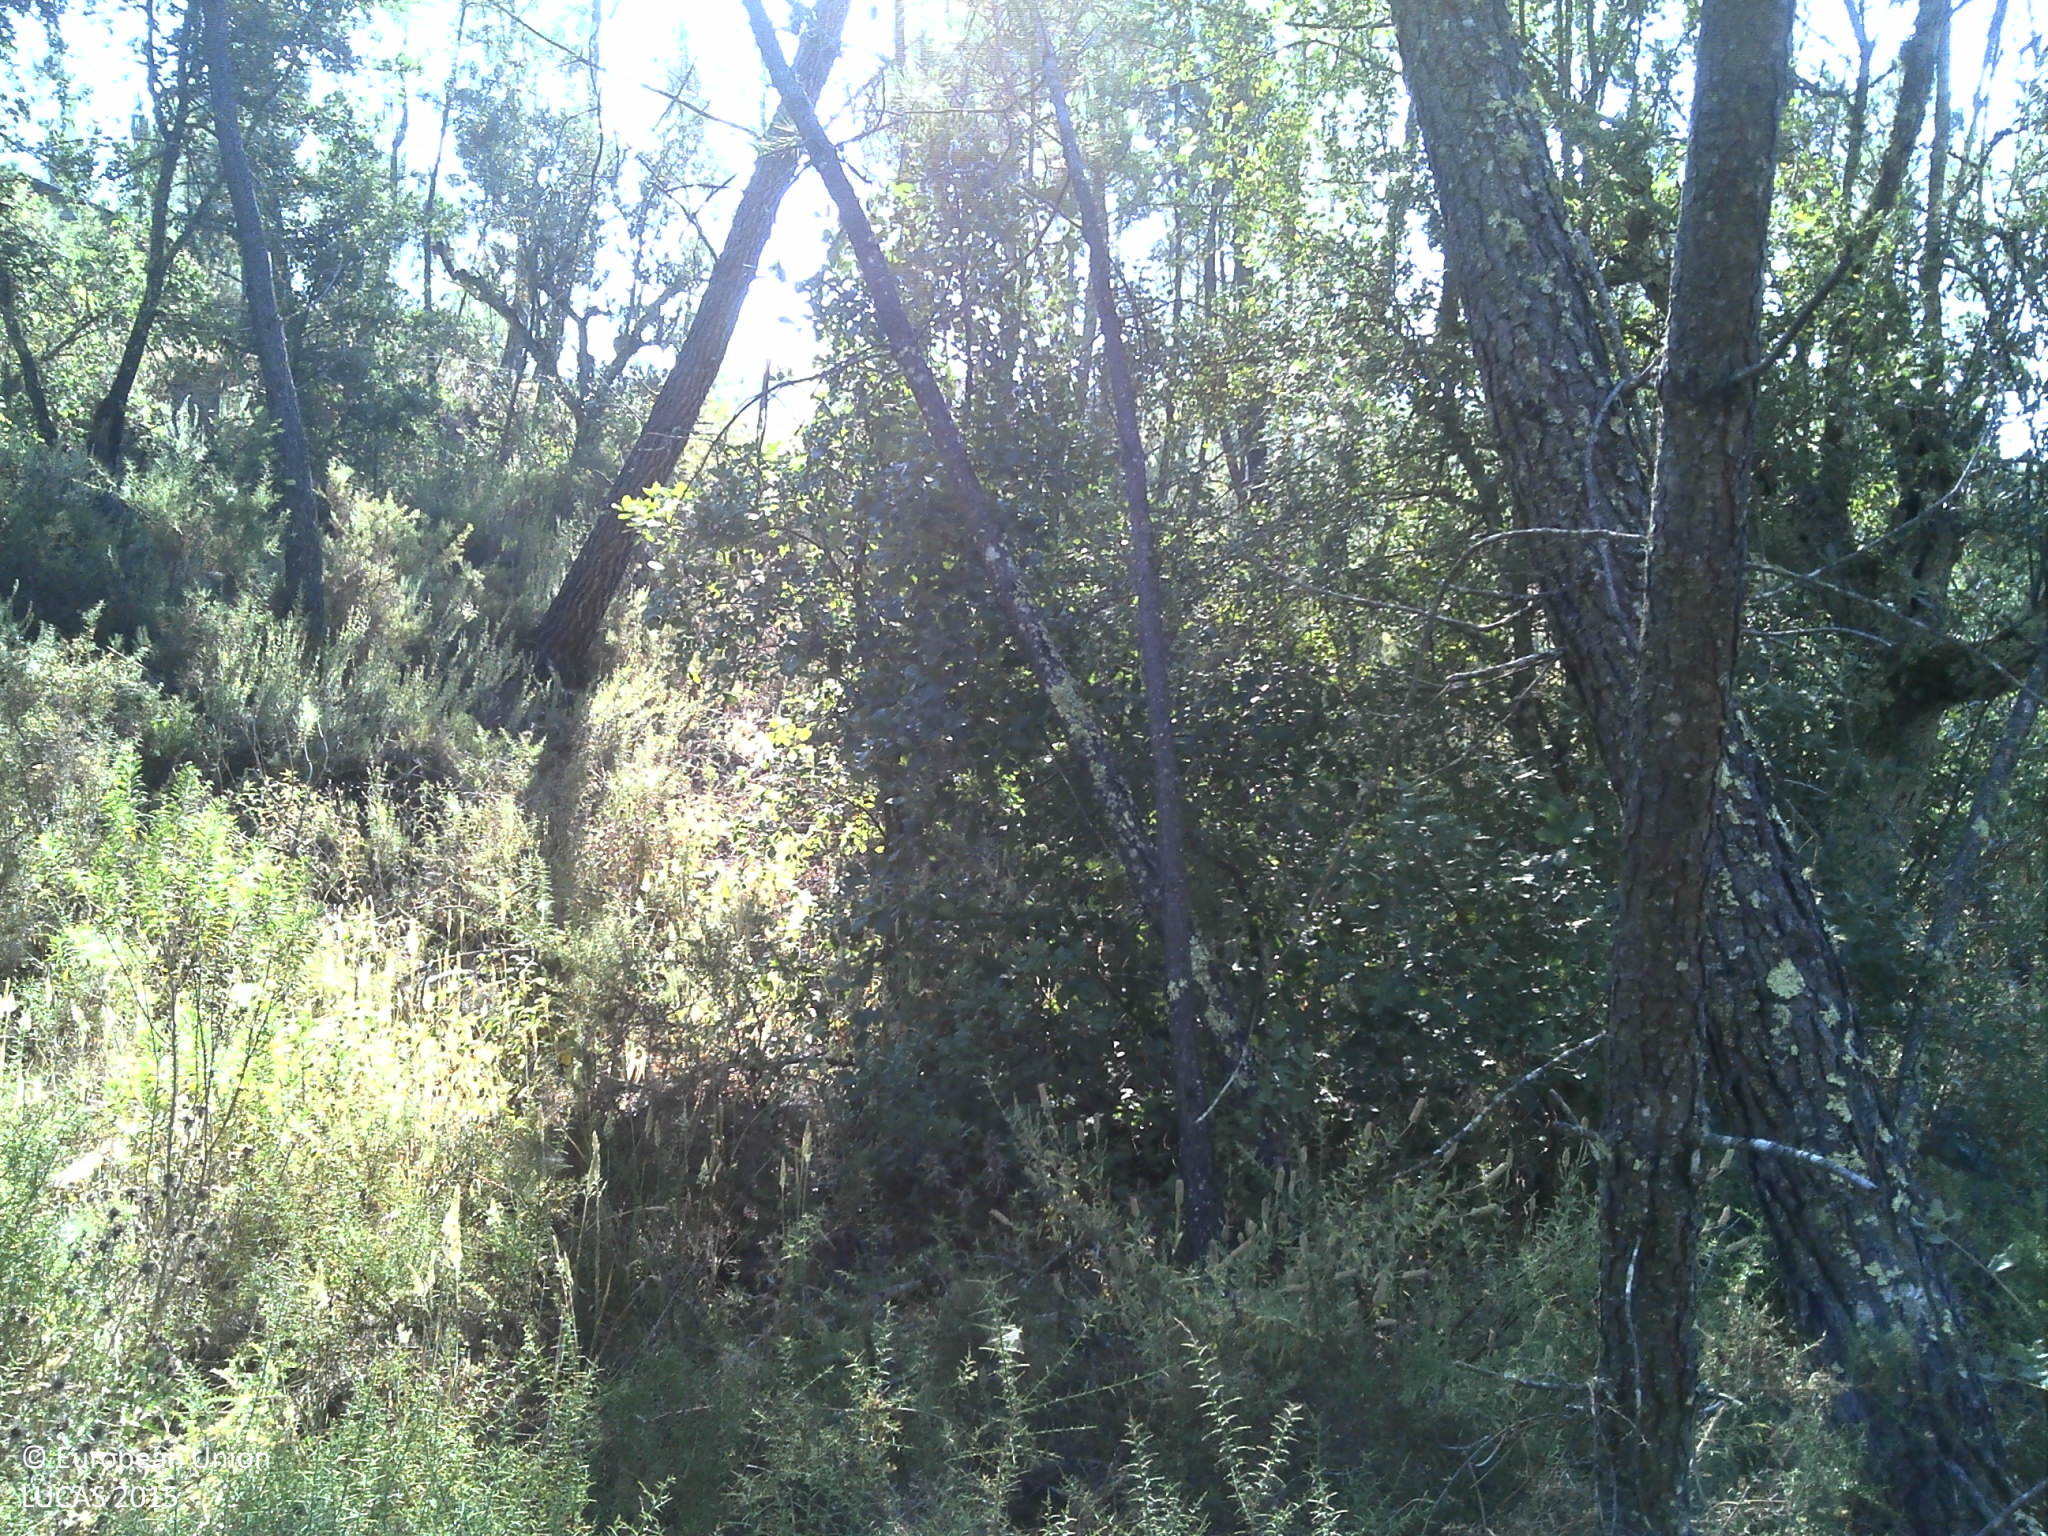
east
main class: Woodland
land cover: Pine dominated coniferous woodland
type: coniferous forest of the mediterranean region
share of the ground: 25 - 50 %
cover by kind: shrubs 75 %, coniferous forest trees 25 %
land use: Forestry
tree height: > 5 m
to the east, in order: Pine dominated coniferous woodland; Ditches and canals; Dry stone walls; Shrubland with sparse tree cover; Broadleaved woodland; Olive groves; Artificial constructions in urban areas; Other fruit trees and berries; Olive groves; Artificial constructions; Olive groves; Dry stone walls; Olive groves; Dry stone walls; Olive groves; Dry stone walls; Rivers and streams; Dry stone walls; Vineyards; Olive groves; Dry stone walls; Ditches and canals; Dry stone walls; Vineyards; Other fruit trees and berries; Shrubland without tree cover
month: July
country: PT
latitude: 39.7646
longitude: -8.1259
